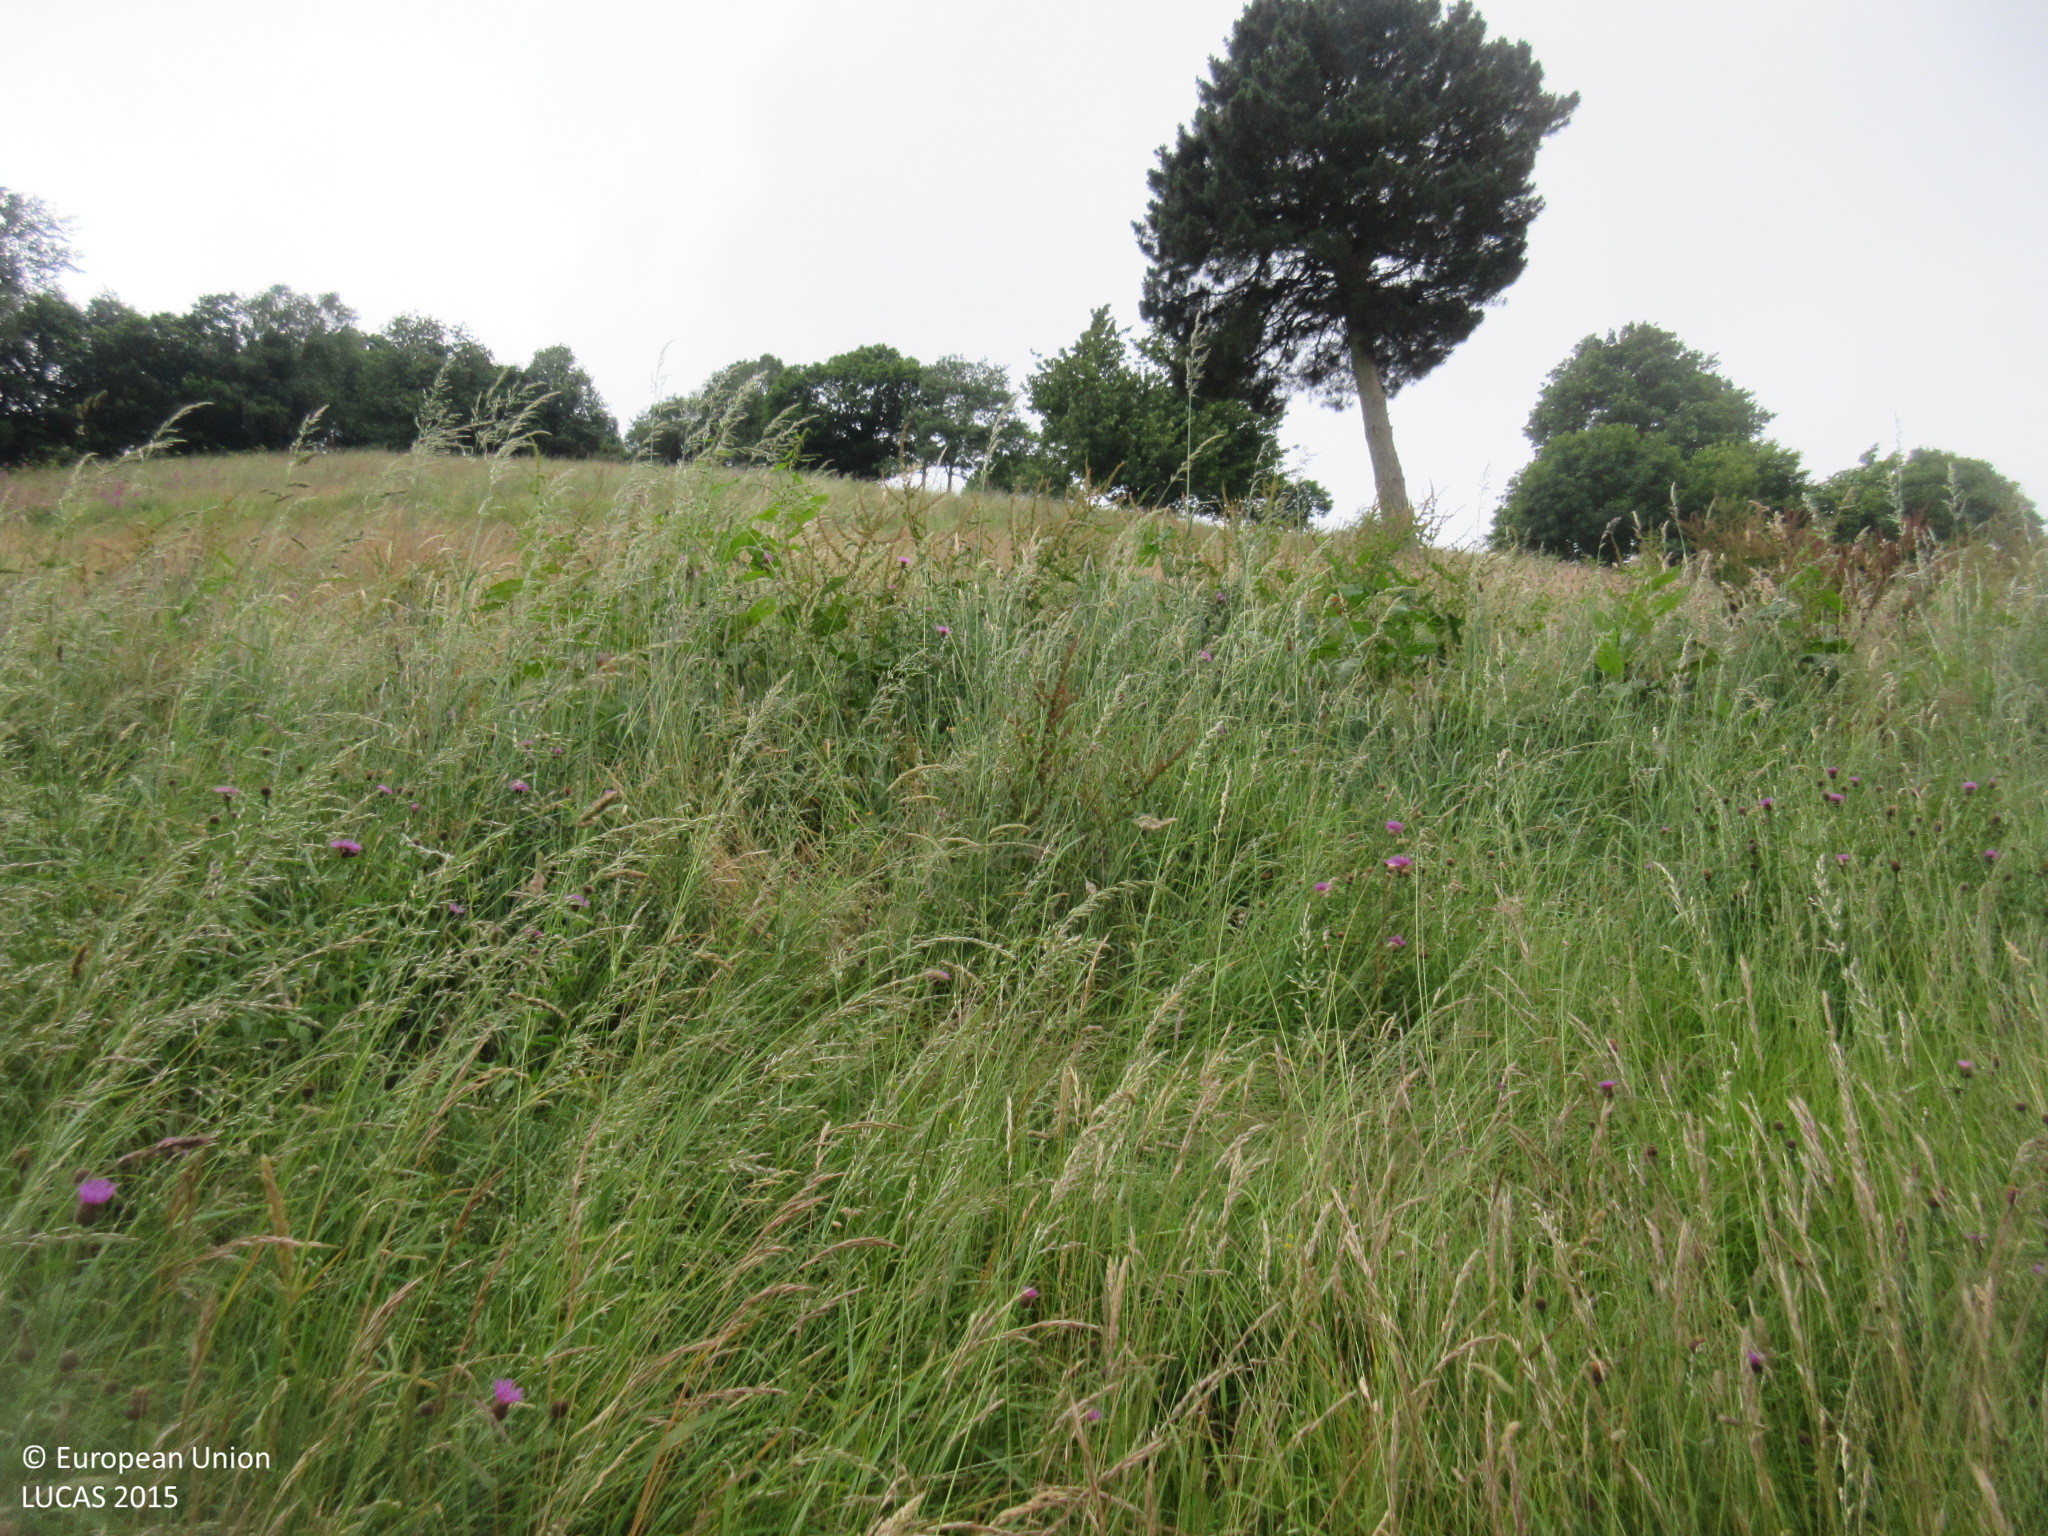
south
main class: Grassland
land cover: Grassland without tree/shrub cover
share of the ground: > 75 %
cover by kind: herbaceous plants 100 %
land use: Agriculture (excluding fallow land and kitchen gardens)
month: June
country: ES
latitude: 43.2815
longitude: -6.3527
